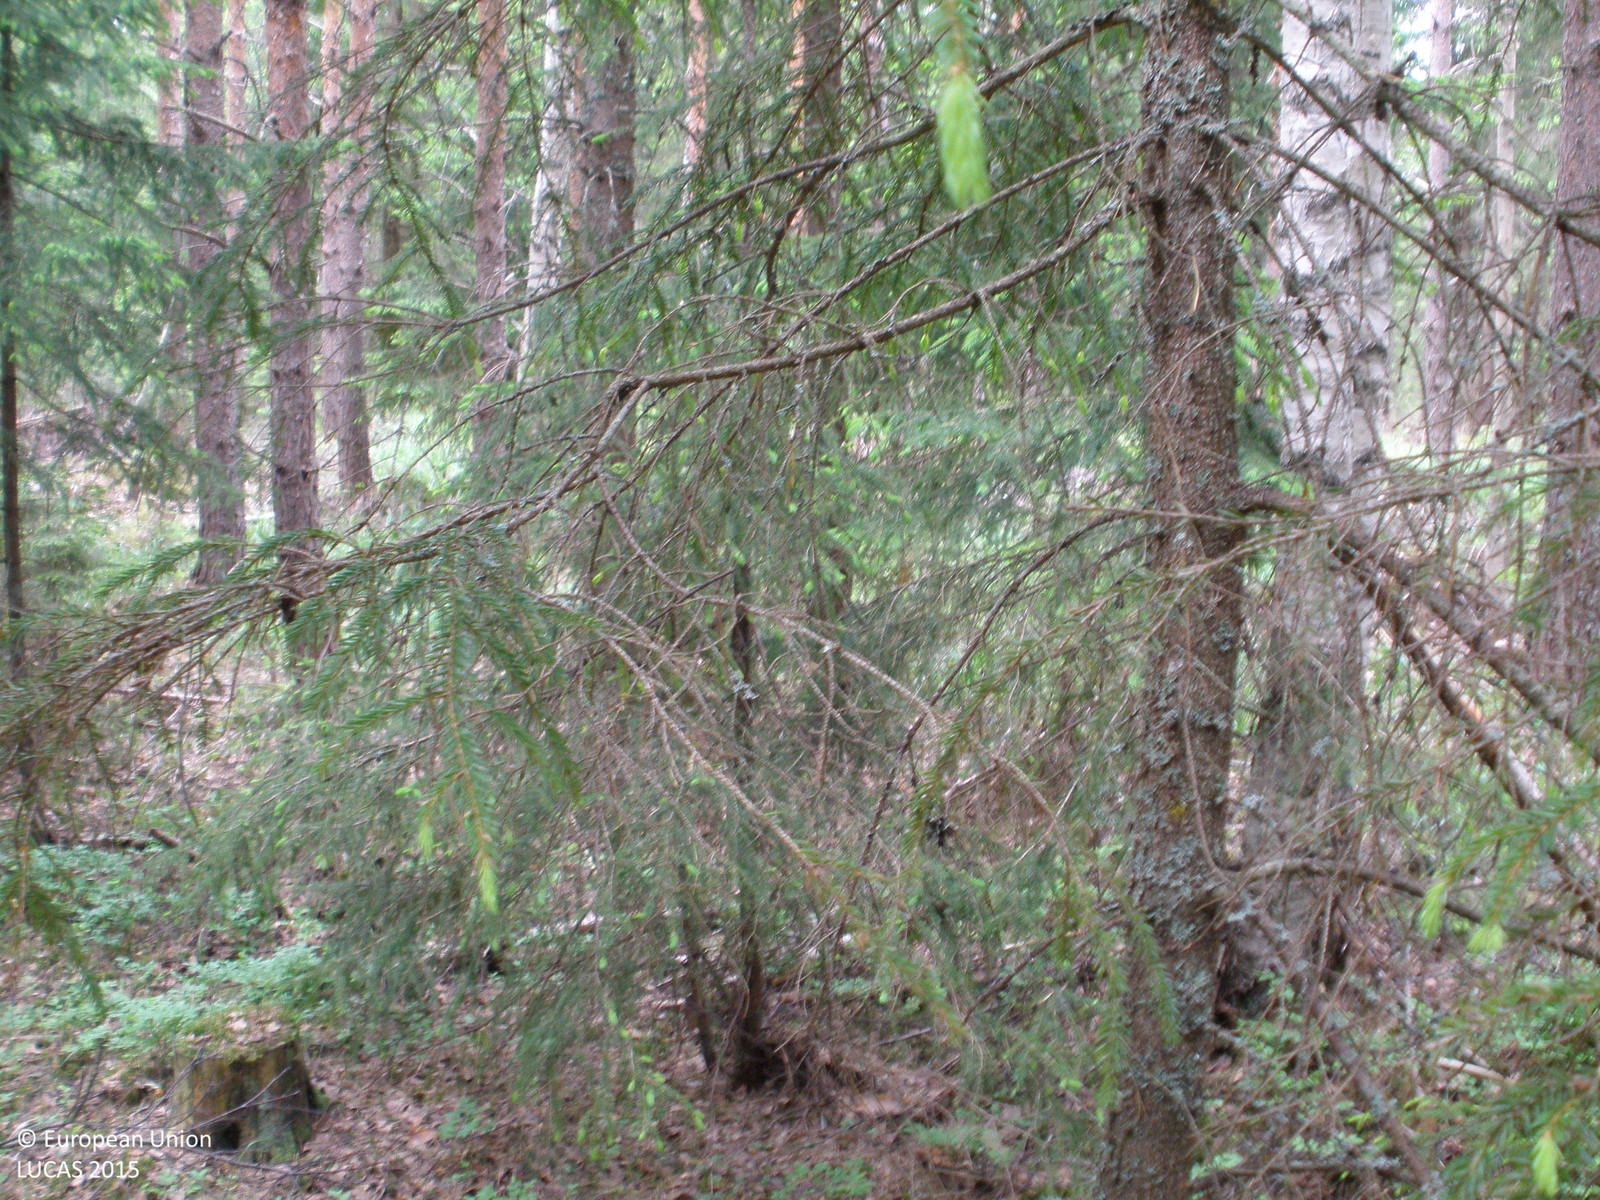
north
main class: Woodland
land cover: Pine dominated mixed woodland
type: boreal forest
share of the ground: > 75 %
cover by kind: coniferous forest trees 60 %, broadleaved forest trees 25 %, herbaceous plants 10 %, shrubs 5 %
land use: Forestry
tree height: > 5 m
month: June
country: FI
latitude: 61.0152
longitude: 24.2117
